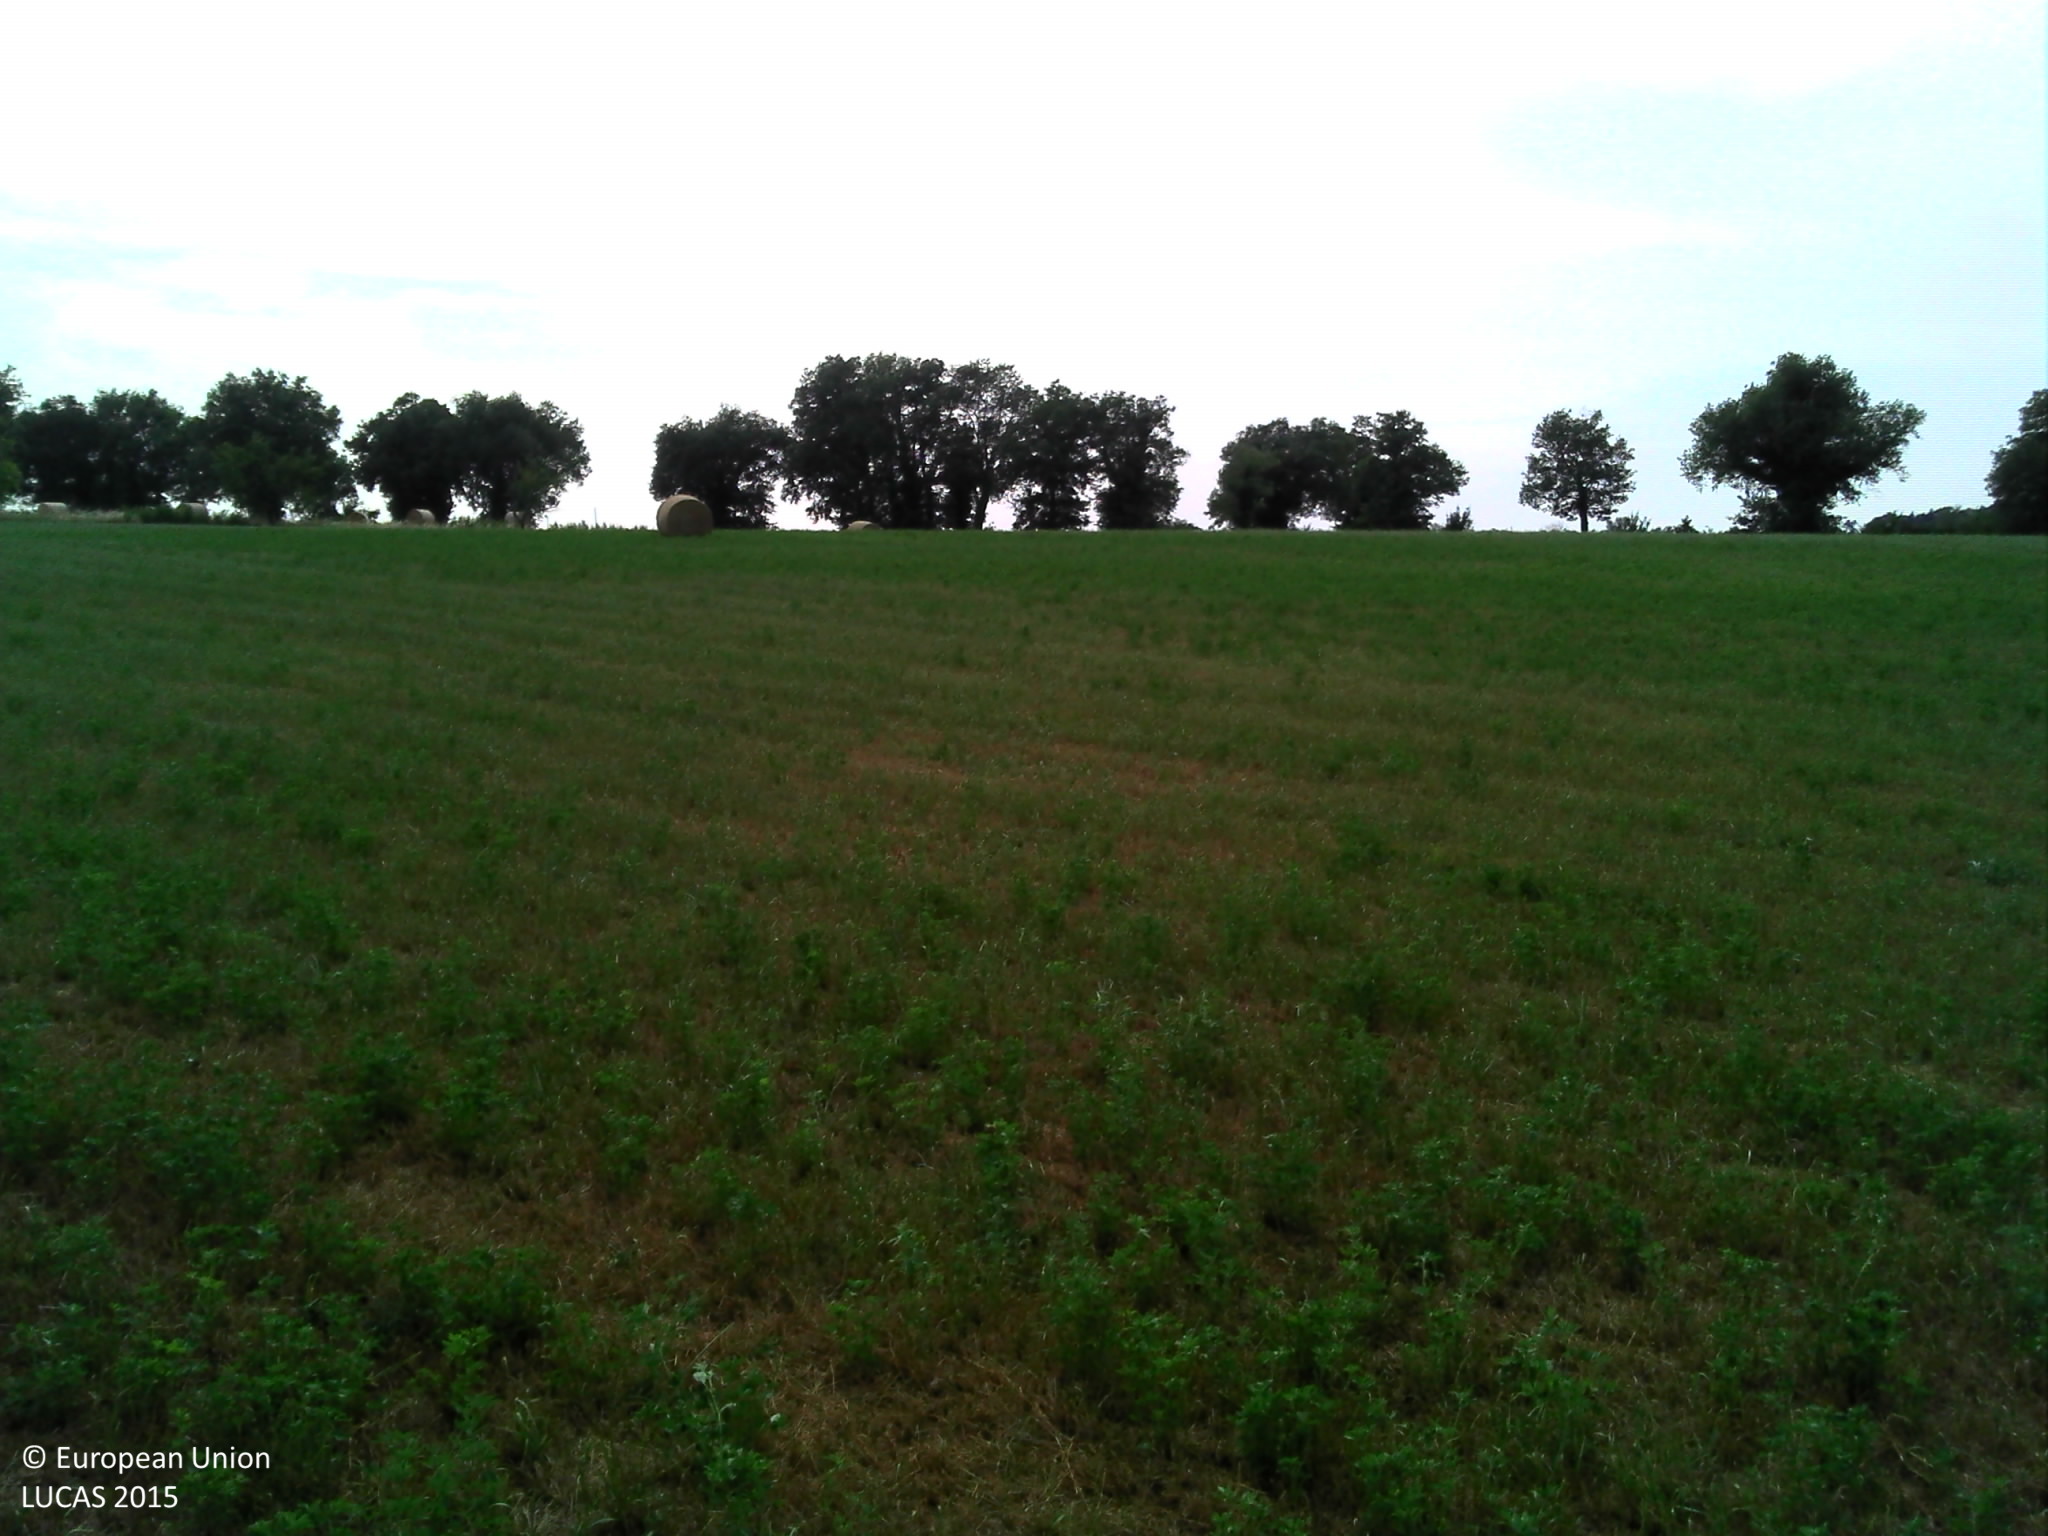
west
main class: Cropland
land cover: Lucerne
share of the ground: > 75 %
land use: Agriculture (excluding fallow land and kitchen gardens)
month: July
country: FR
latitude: 43.6134
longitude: 0.9922
